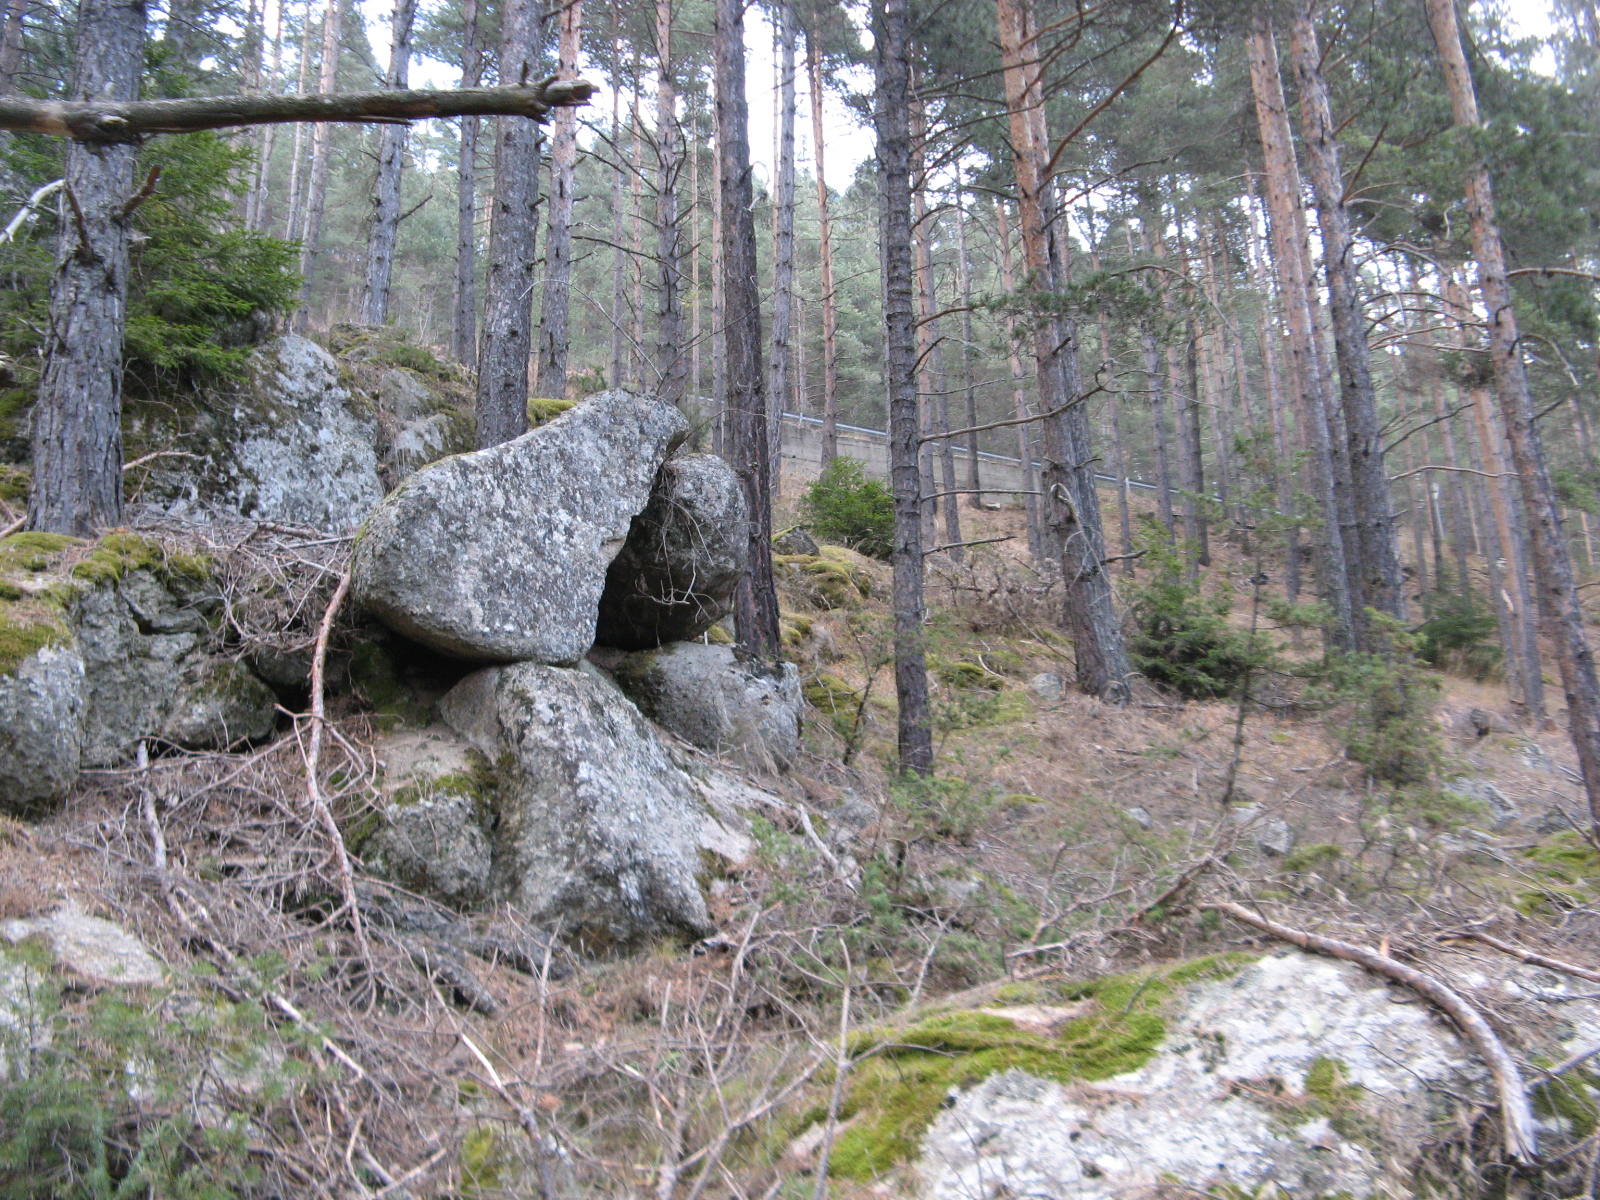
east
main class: Woodland
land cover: Pine dominated coniferous woodland
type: hemiboreal forest and nemoral coniferous forest and mixed broadleaved-coniferous forest
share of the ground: > 75 %
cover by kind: coniferous forest trees 85 %, herbaceous plants 5 %, lichens and mosses 5 %, unconsolidated bare surface 5 %
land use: Forestry
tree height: > 5 m
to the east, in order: Pine dominated coniferous woodland; Artificial constructions; Paved roads, cycling and walking lanes; Ditches and canals; Rocks and stones; Pine dominated coniferous woodland; Grassland with sparse tree/shrub cover; Grassland without tree/shrub cover
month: December
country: BG
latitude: 41.6345
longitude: 24.1647
